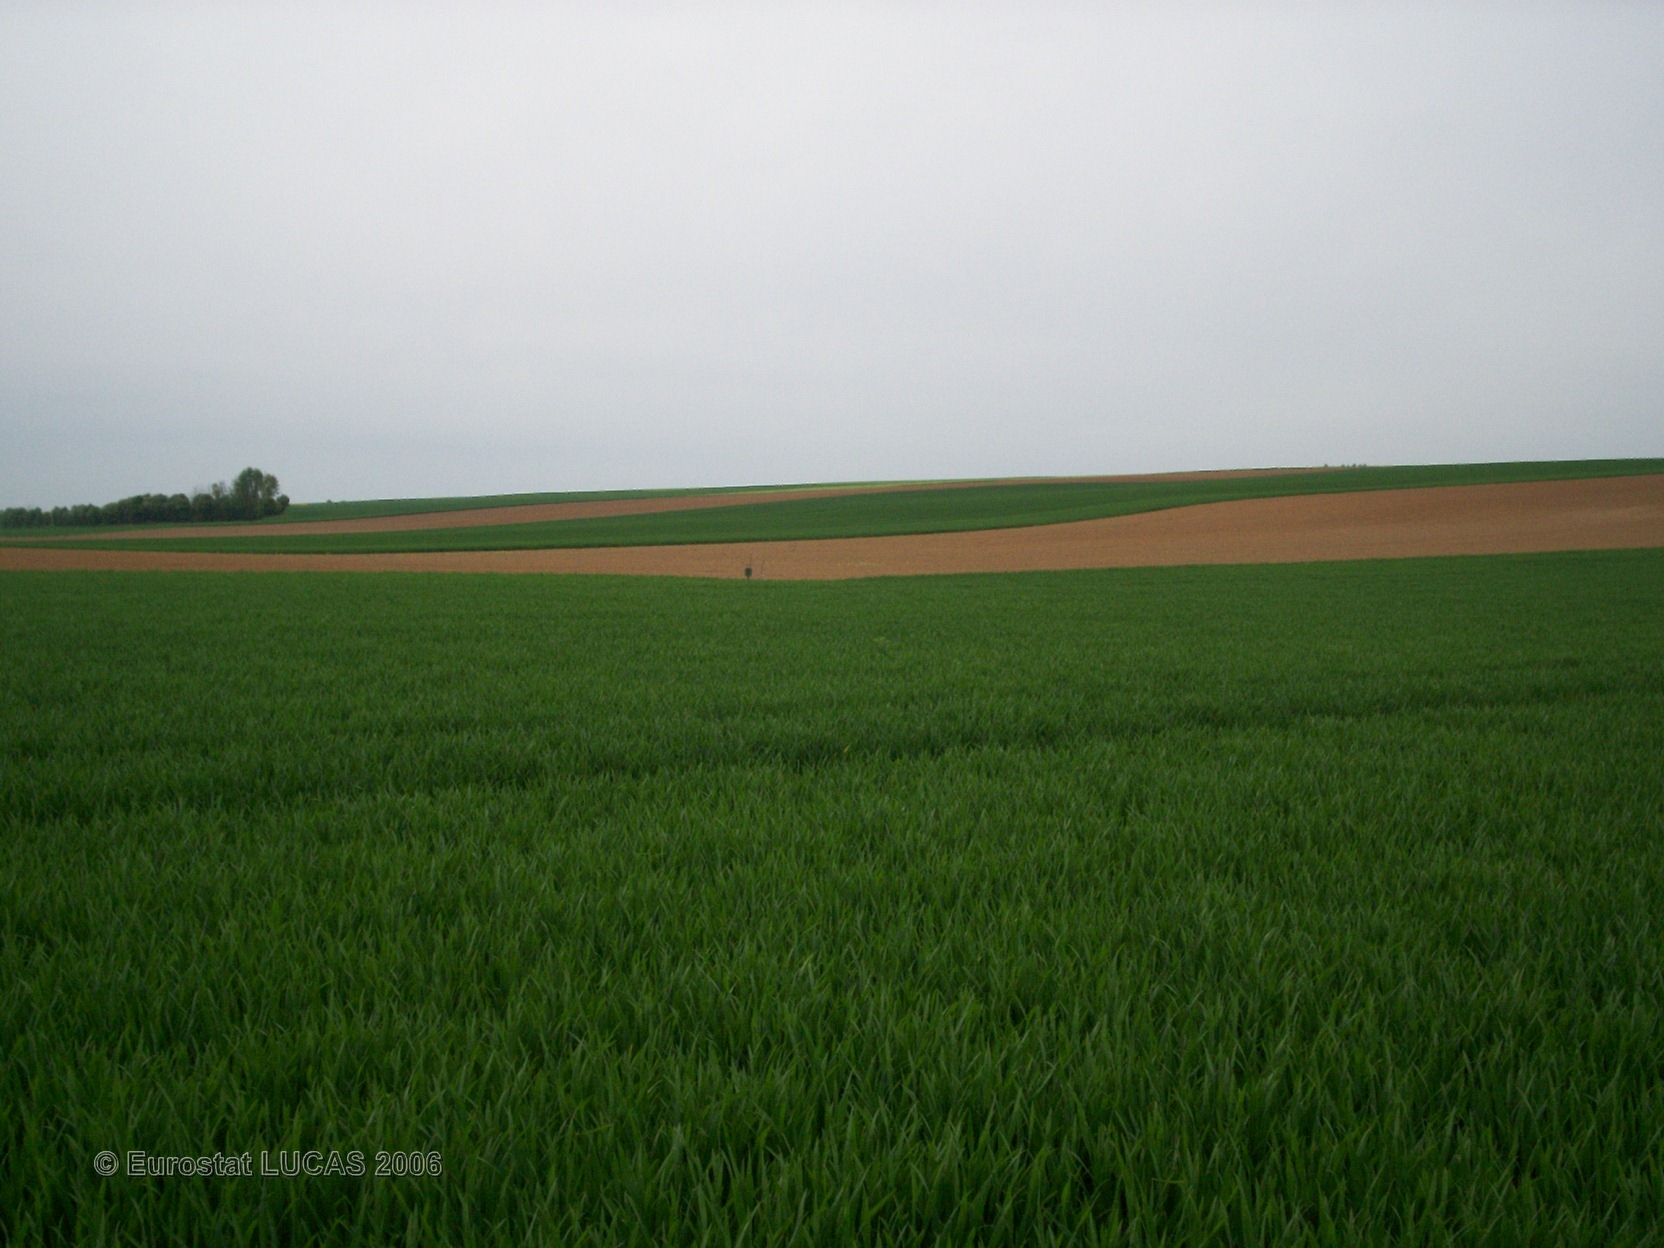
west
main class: Cropland
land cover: Common wheat
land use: Agriculture (excluding fallow land and kitchen gardens)
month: May
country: FR
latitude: 50.2719
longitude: 2.6502
